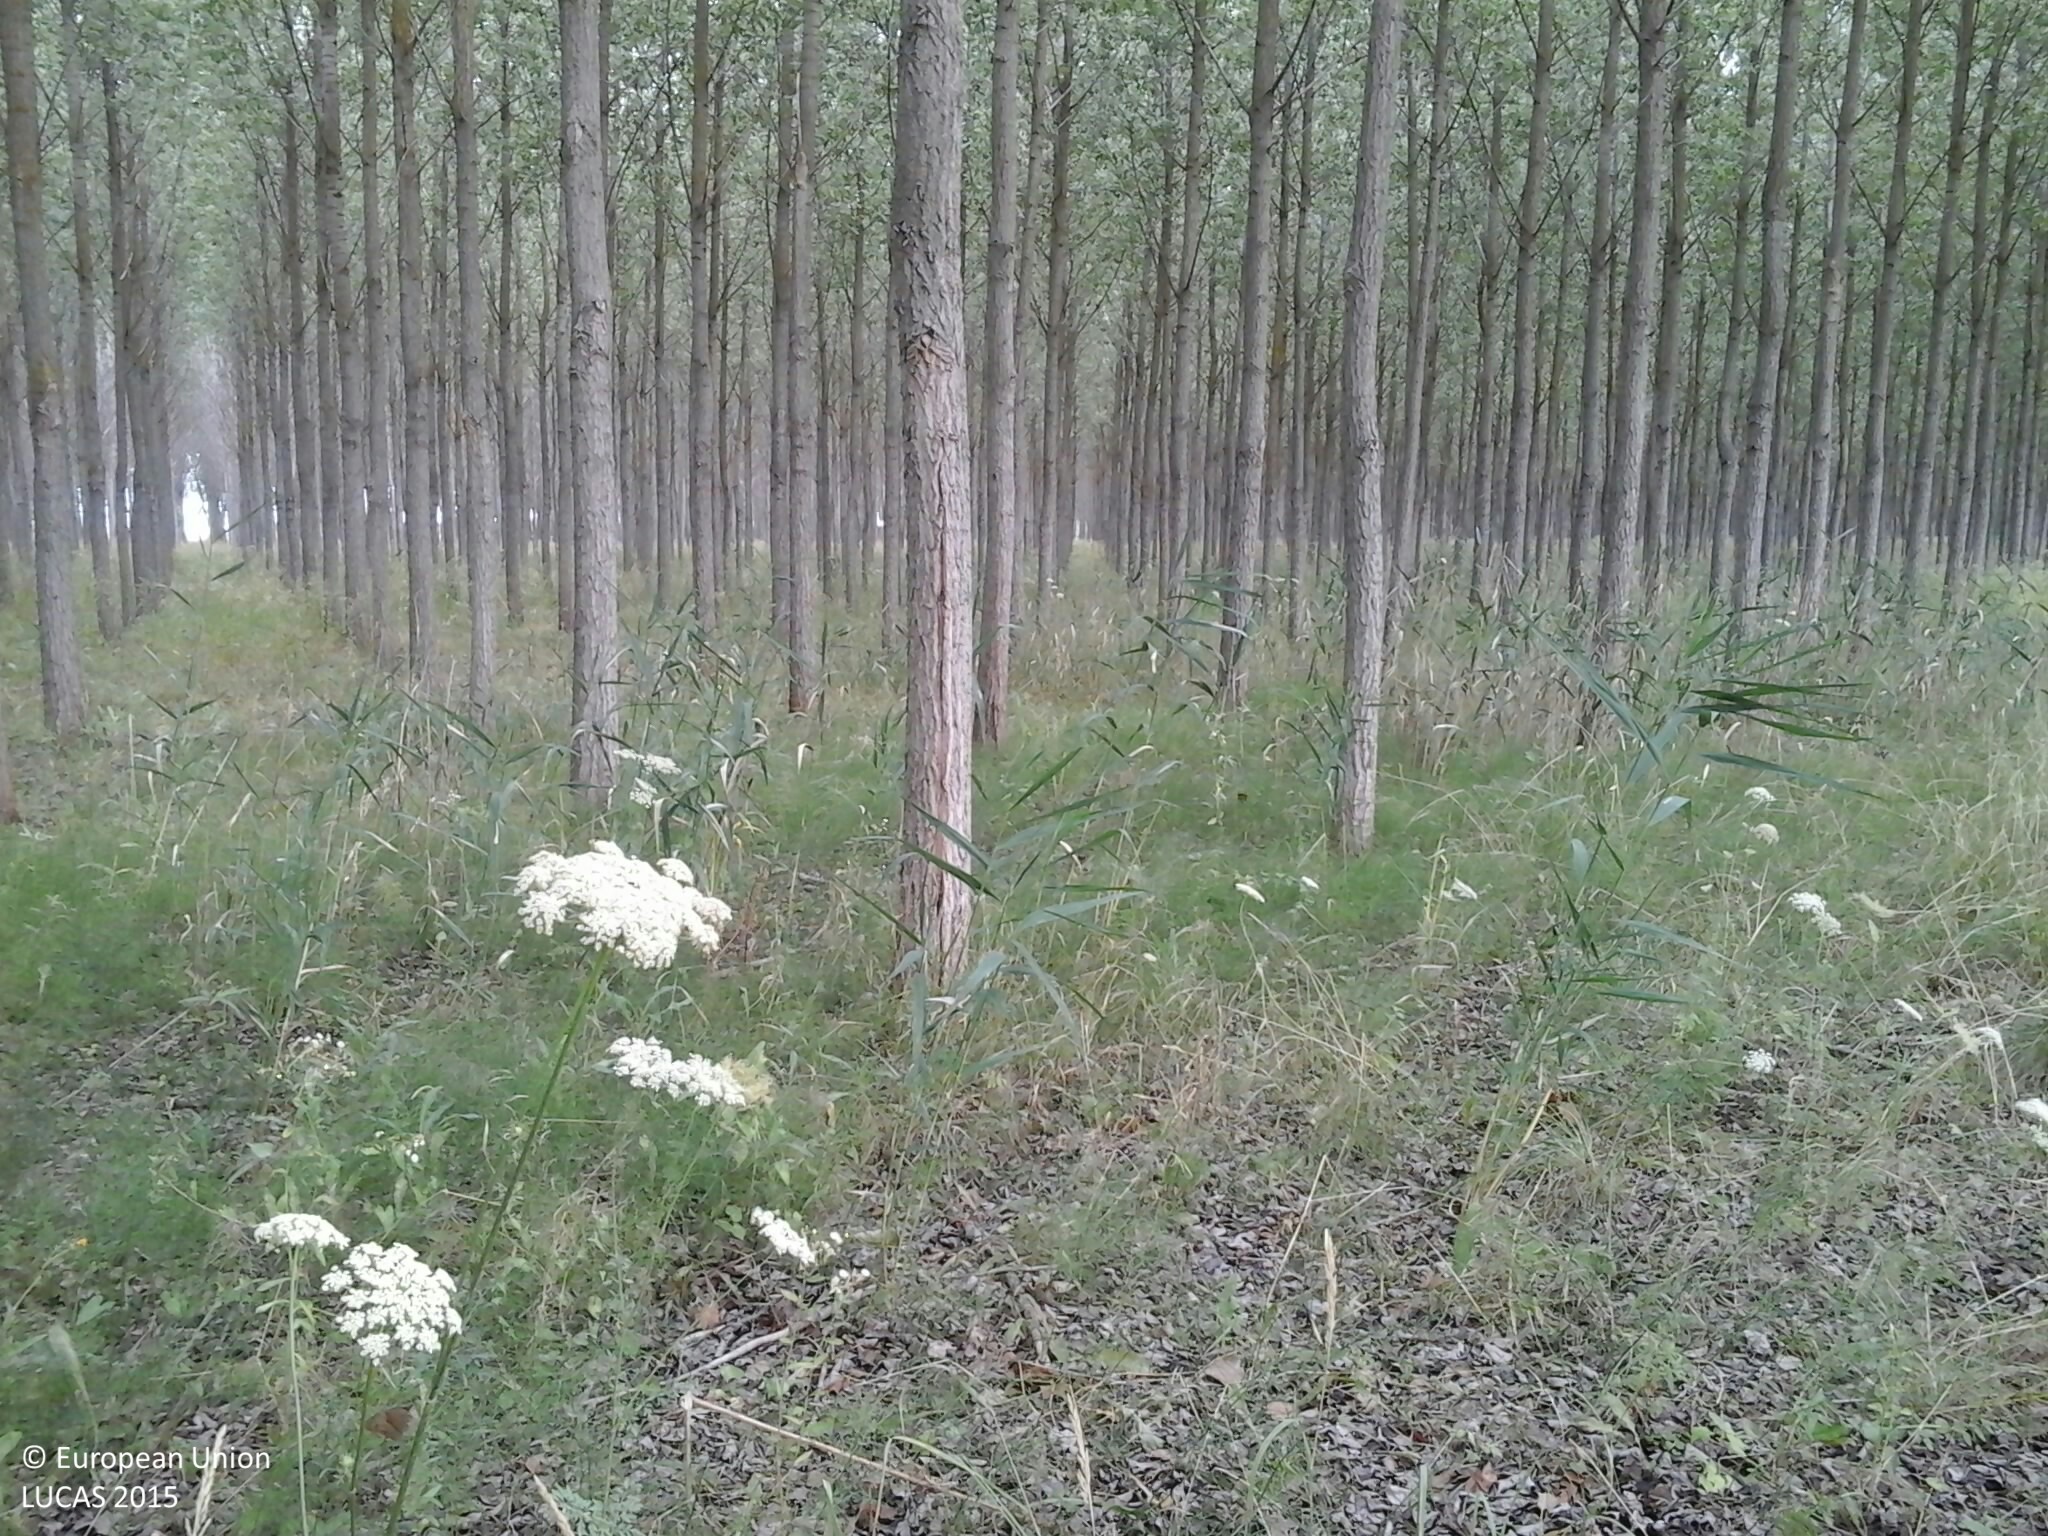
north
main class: Woodland
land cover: Broadleaved woodland
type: non-riverine alder, birch or aspen forest
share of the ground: 50 - 75 %
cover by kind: broadleaved forest trees 80 %, herbaceous plants 20 %
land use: Forestry
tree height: > 5 m
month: July
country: HU
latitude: 47.7203
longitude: 20.8742
